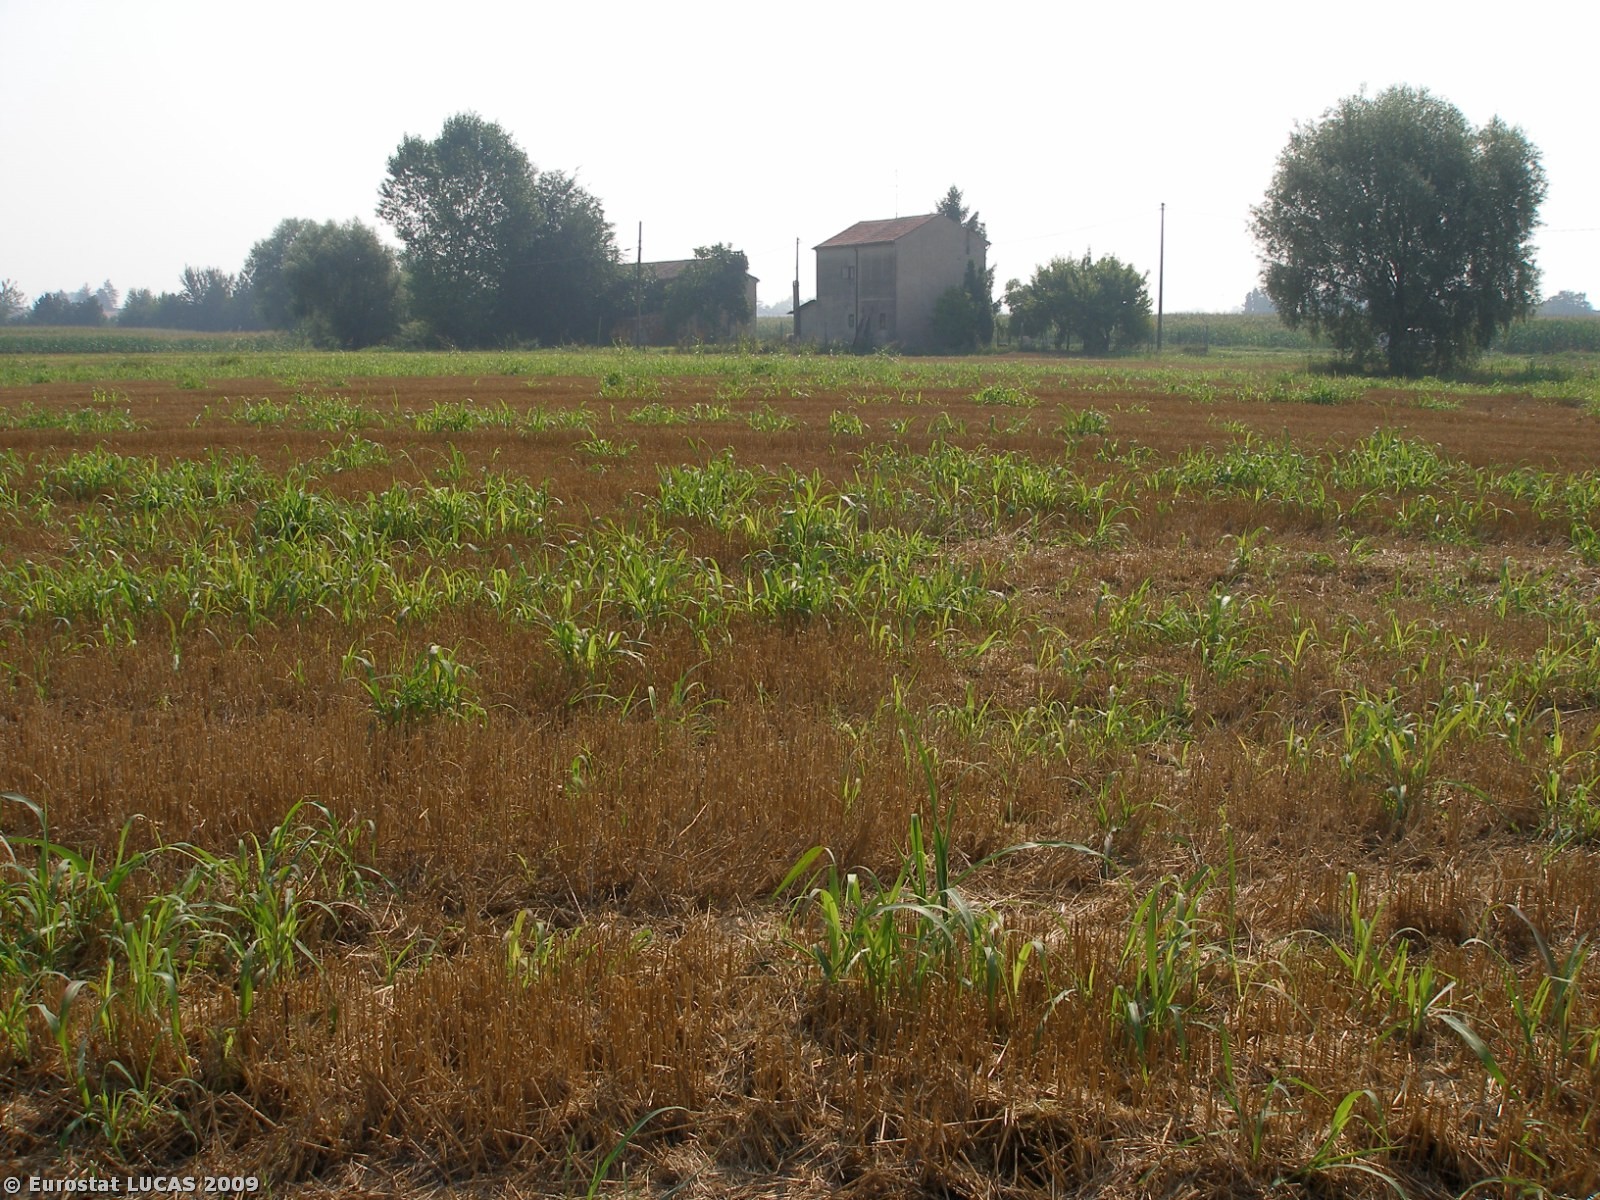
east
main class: Cropland
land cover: Maize
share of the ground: > 75 %
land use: Agriculture (excluding fallow land and kitchen gardens)
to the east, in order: Maize; Ditches and canals; Durum wheat; Fences; Artificial constructions in urban areas; Fences; Paved roads, cycling and walking lanes; Grass margins; Ditches and canals; Tracks; Maize
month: July
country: IT
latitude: 45.0034
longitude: 11.7348
